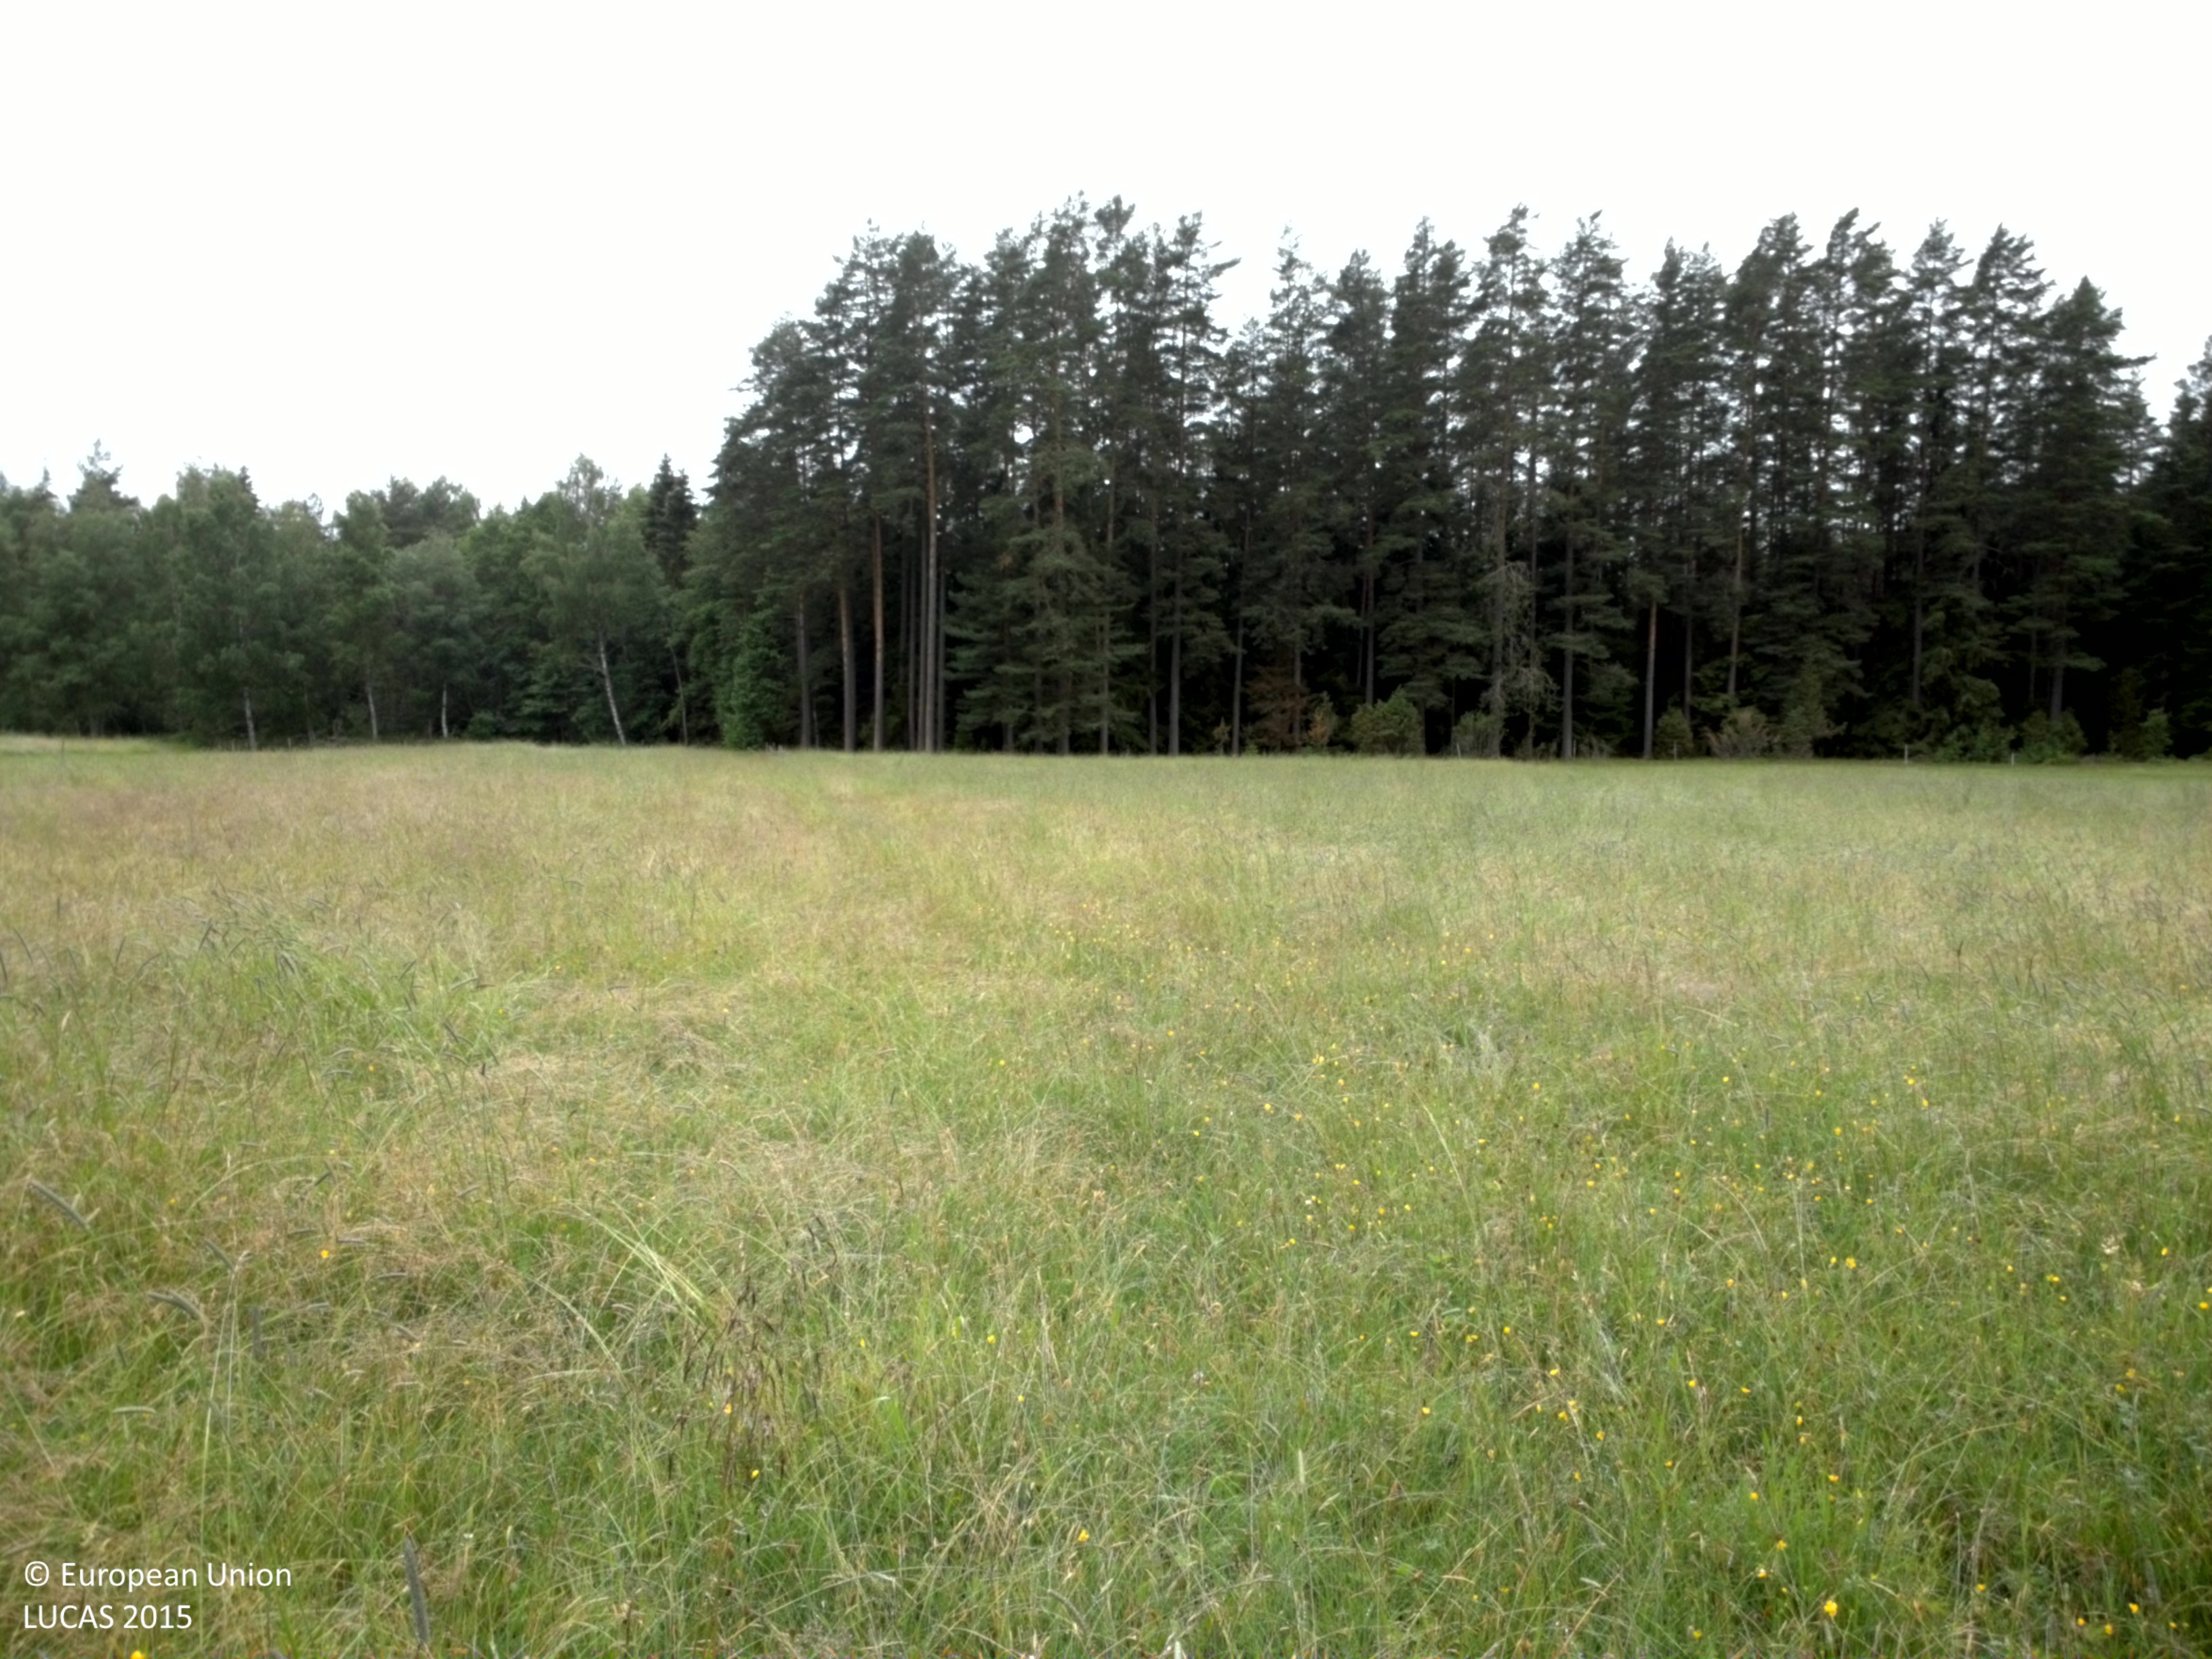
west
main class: Grassland
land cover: Grassland without tree/shrub cover
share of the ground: > 75 %
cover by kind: herbaceous plants 100 %
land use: Agriculture (excluding fallow land and kitchen gardens)
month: July
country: SE
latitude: 58.4656
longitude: 14.0221
